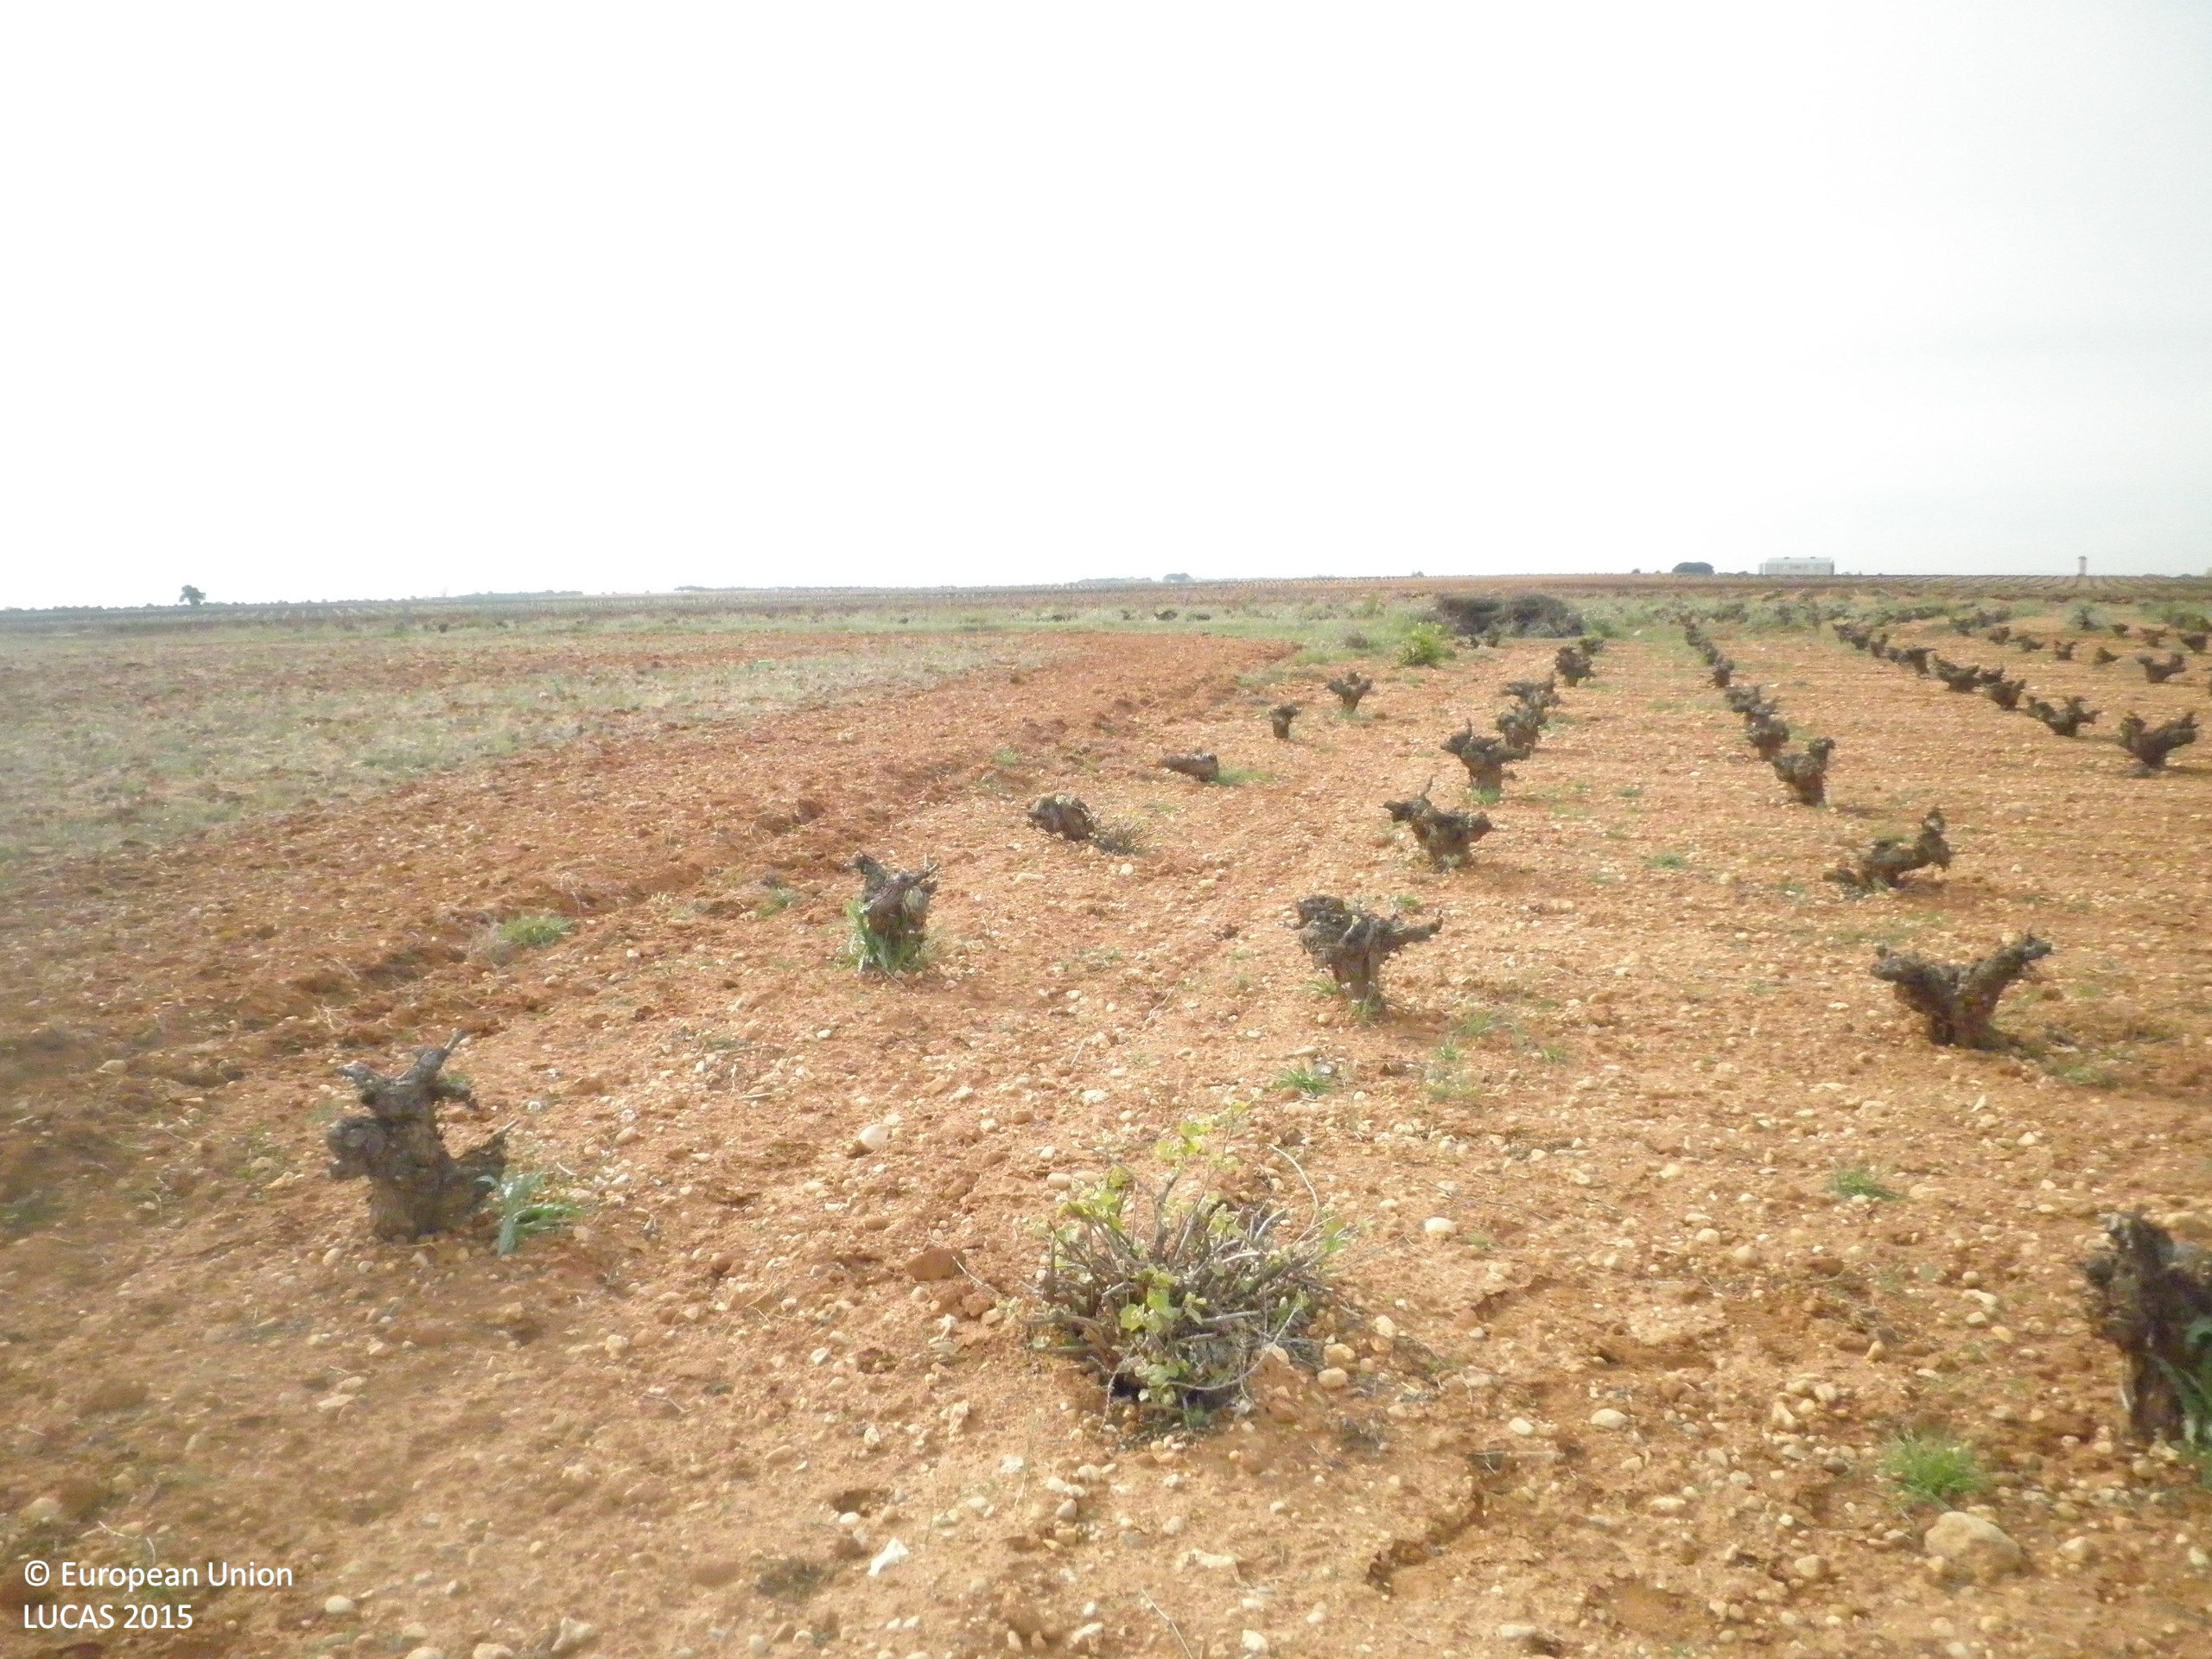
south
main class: Cropland
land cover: Vineyards
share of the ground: < 10 %
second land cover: Other bare soil
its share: > 75 %
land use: Agriculture (excluding fallow land and kitchen gardens)
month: April
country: ES
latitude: 39.3802
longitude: -2.7246
